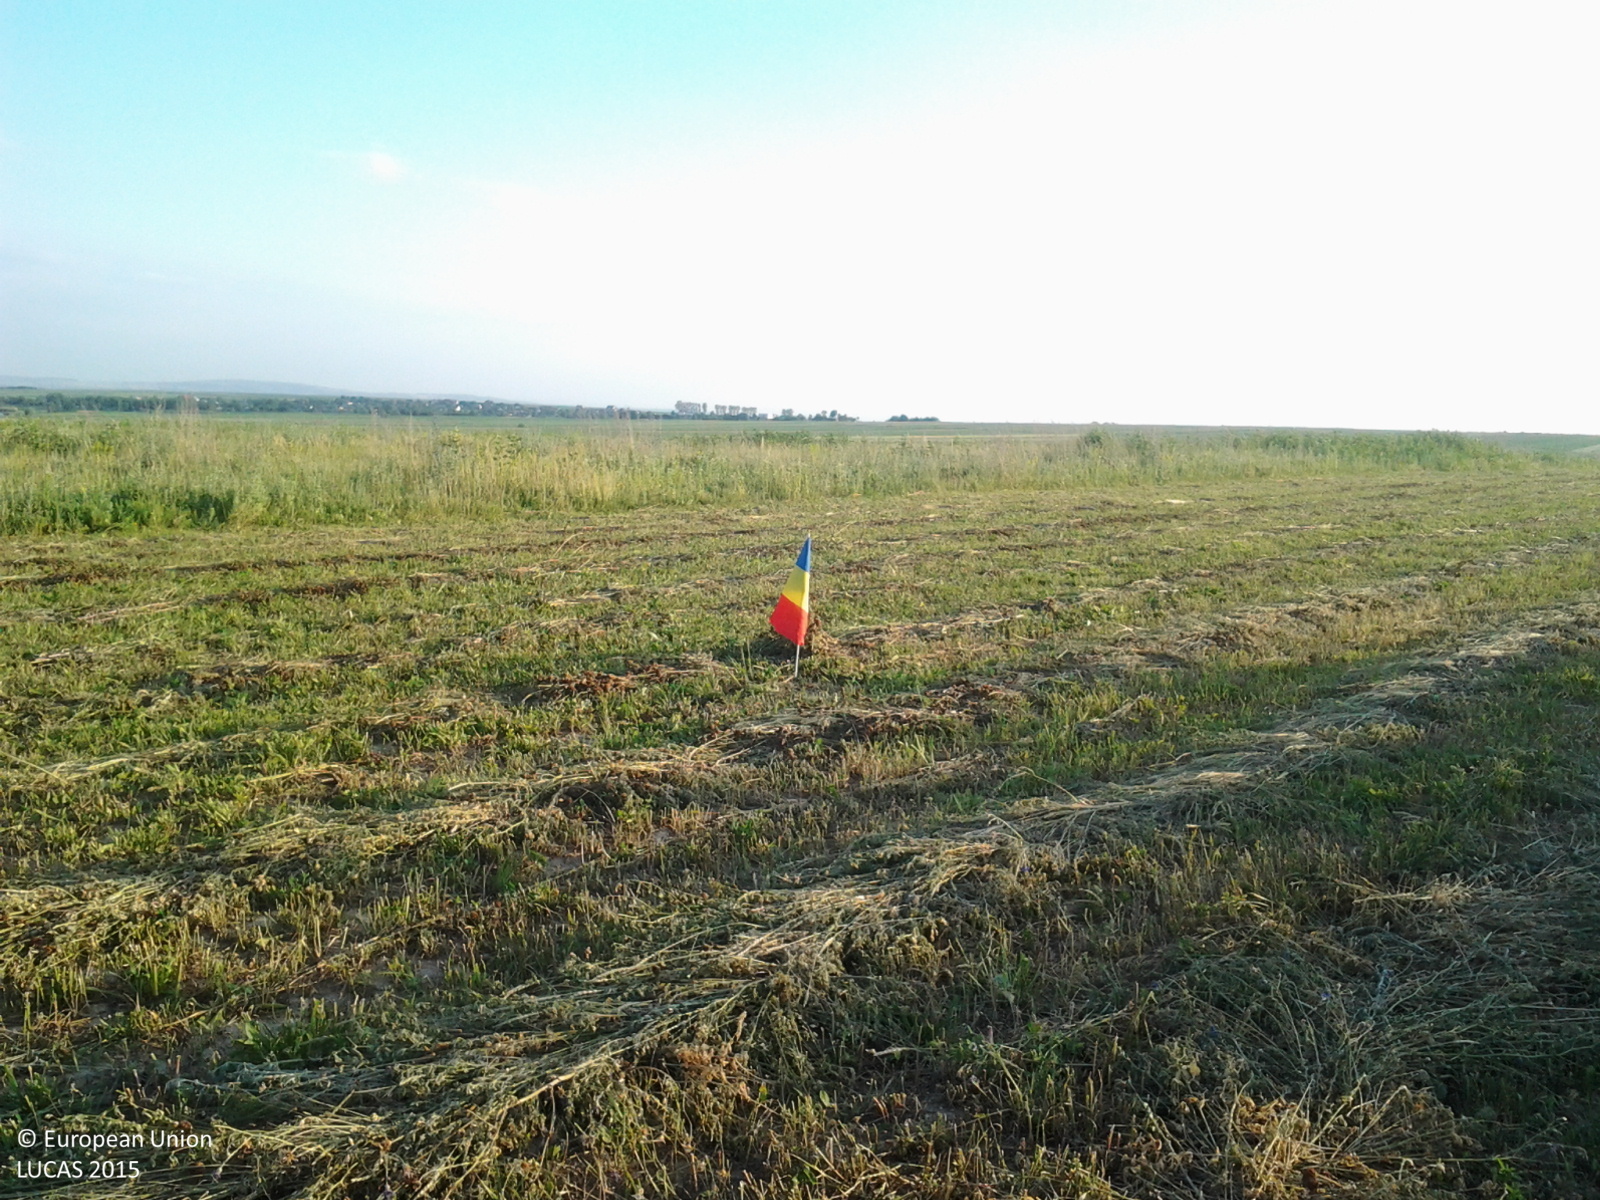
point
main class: Grassland
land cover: Grassland without tree/shrub cover
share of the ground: > 75 %
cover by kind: herbaceous plants 100 %
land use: Agriculture (excluding fallow land and kitchen gardens)
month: June
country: RO
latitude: 47.7350
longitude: 26.5330
